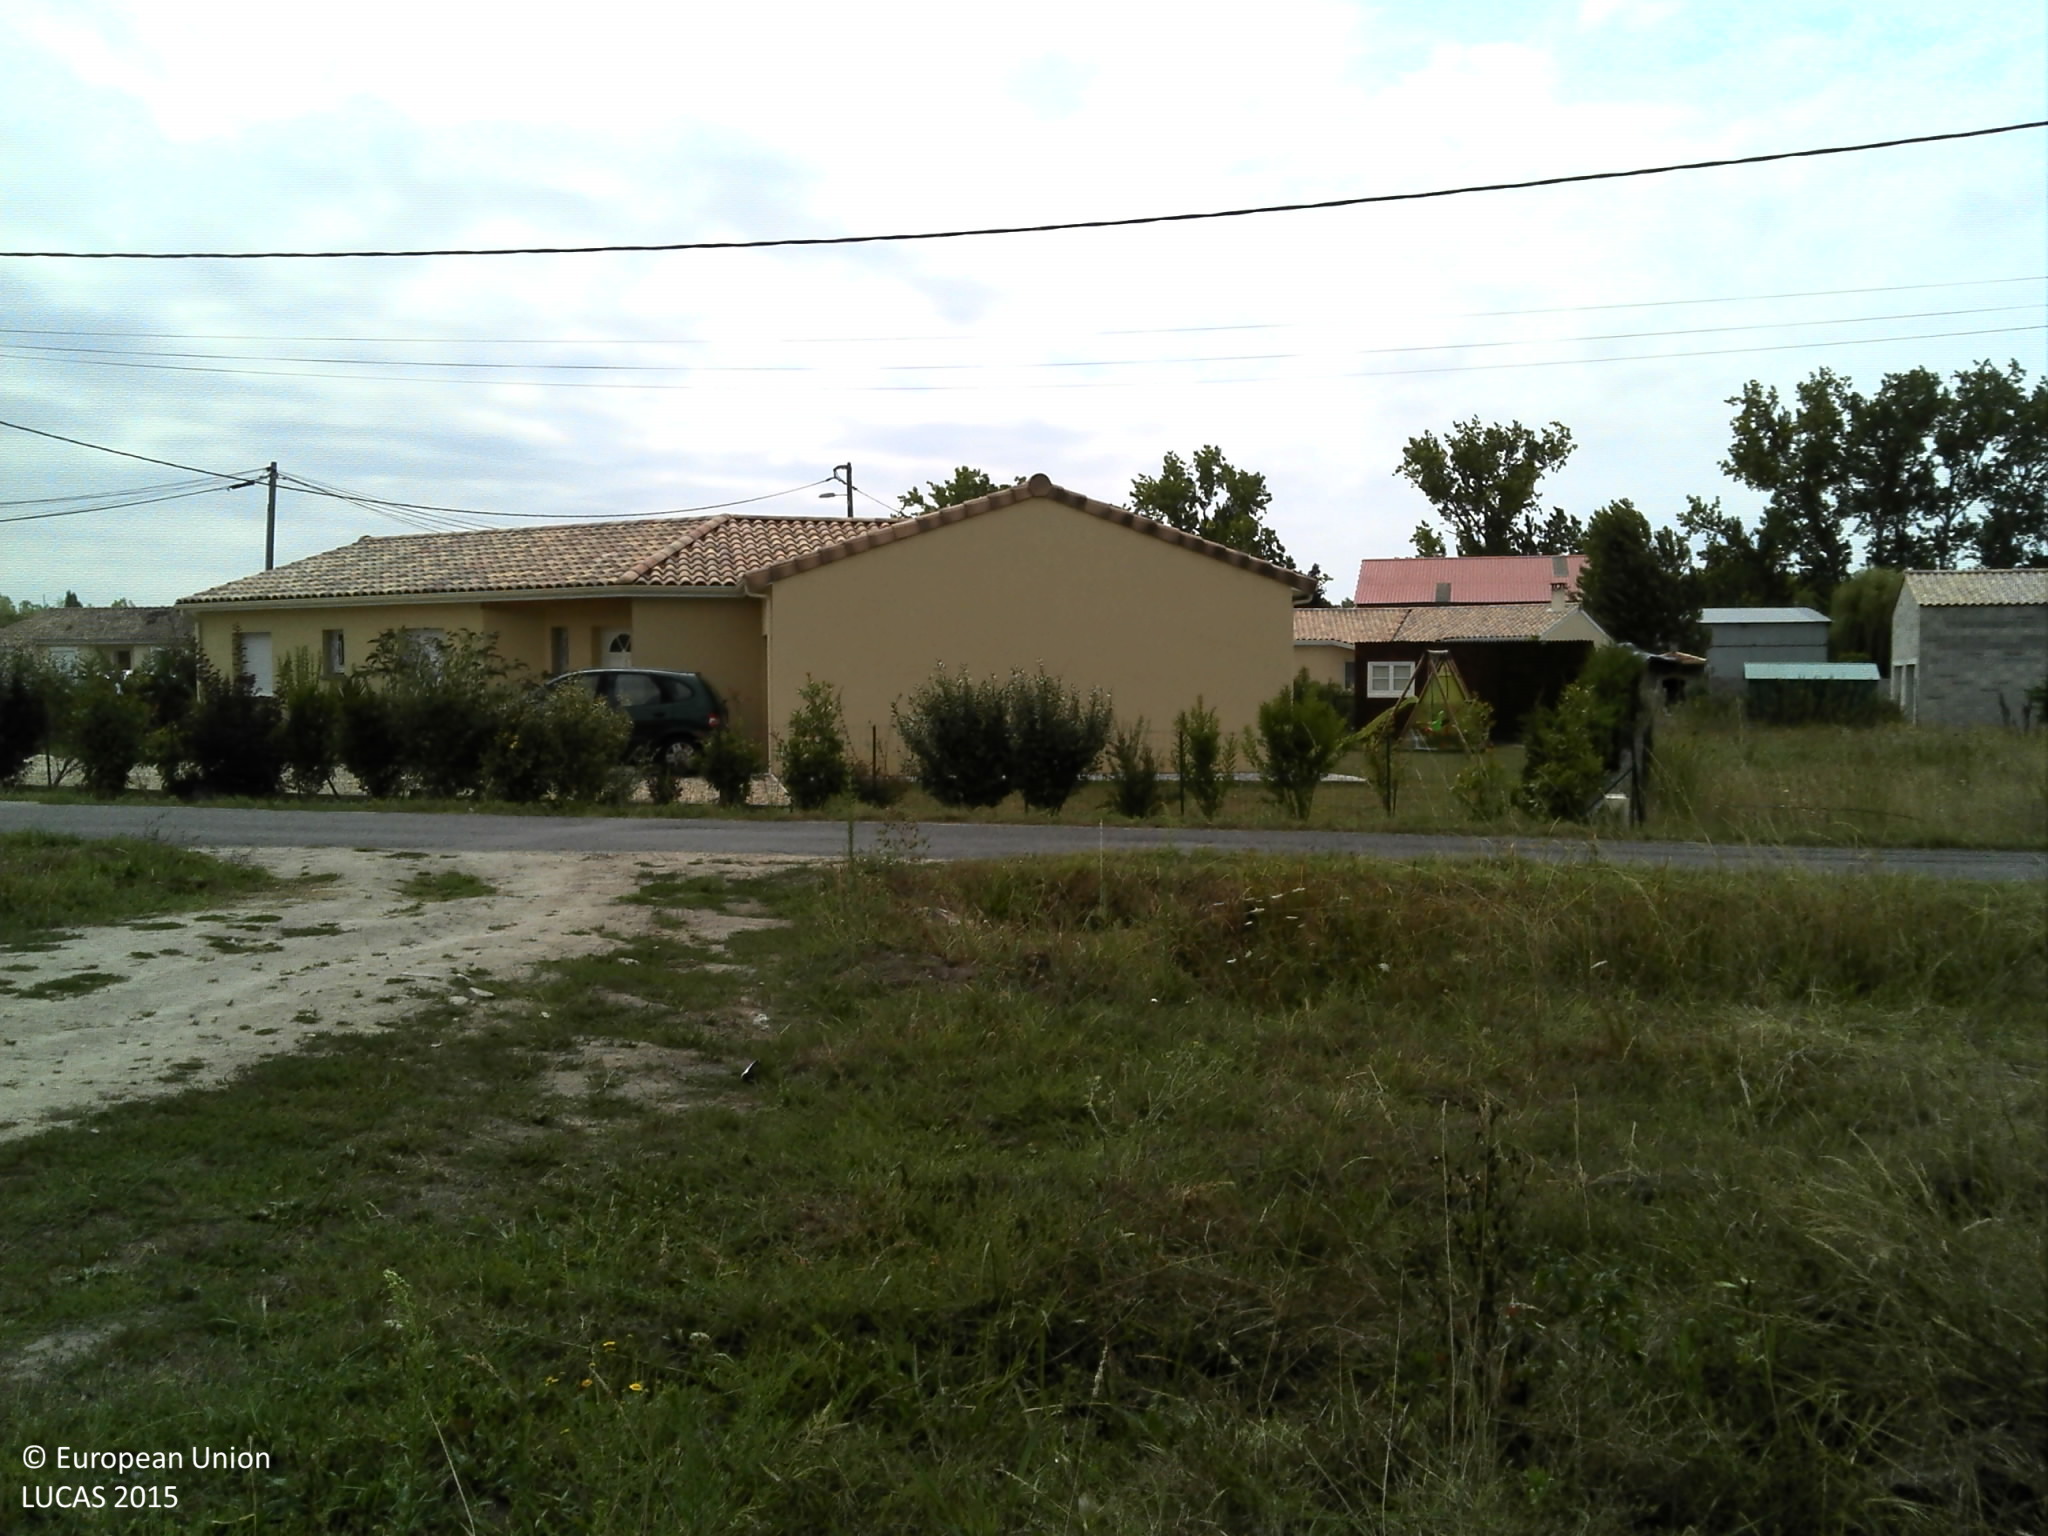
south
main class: Woodland
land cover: Broadleaved woodland
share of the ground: > 75 %
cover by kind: broadleaved forest trees 70 %, shrubs 30 %
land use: Semi-natural and natural areas not in use
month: August
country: FR
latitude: 45.2054
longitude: -0.6007
